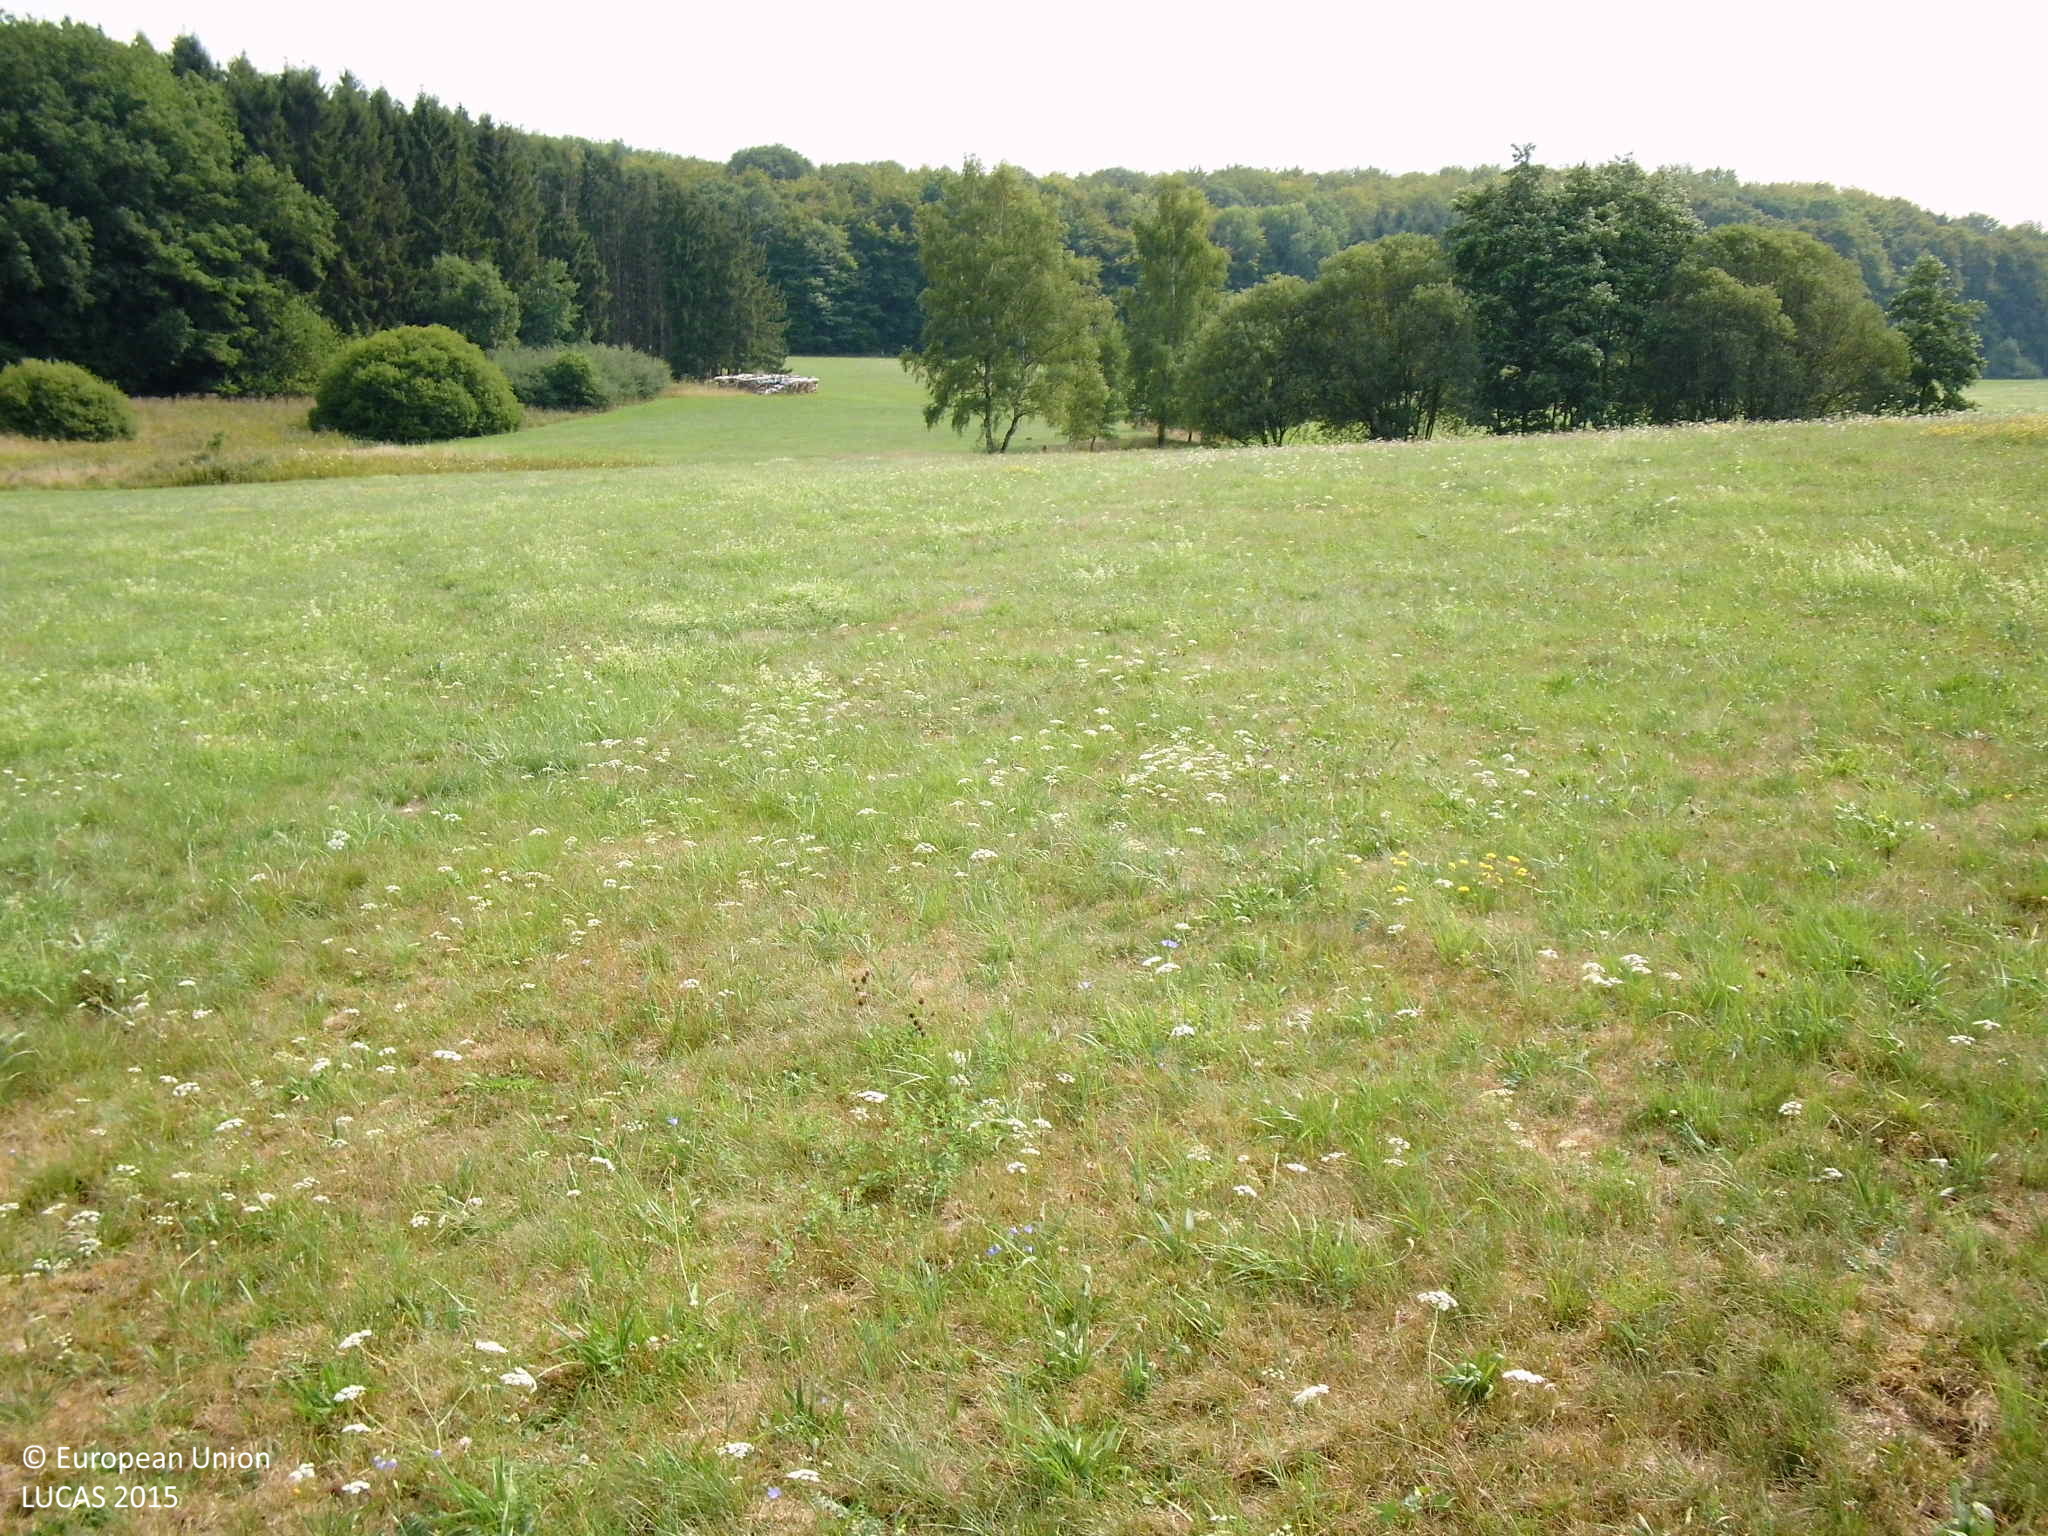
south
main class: Grassland
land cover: Grassland without tree/shrub cover
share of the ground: > 75 %
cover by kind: herbaceous plants 100 %
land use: Agriculture (excluding fallow land and kitchen gardens)
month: August
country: DE
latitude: 50.6612
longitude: 8.5998
